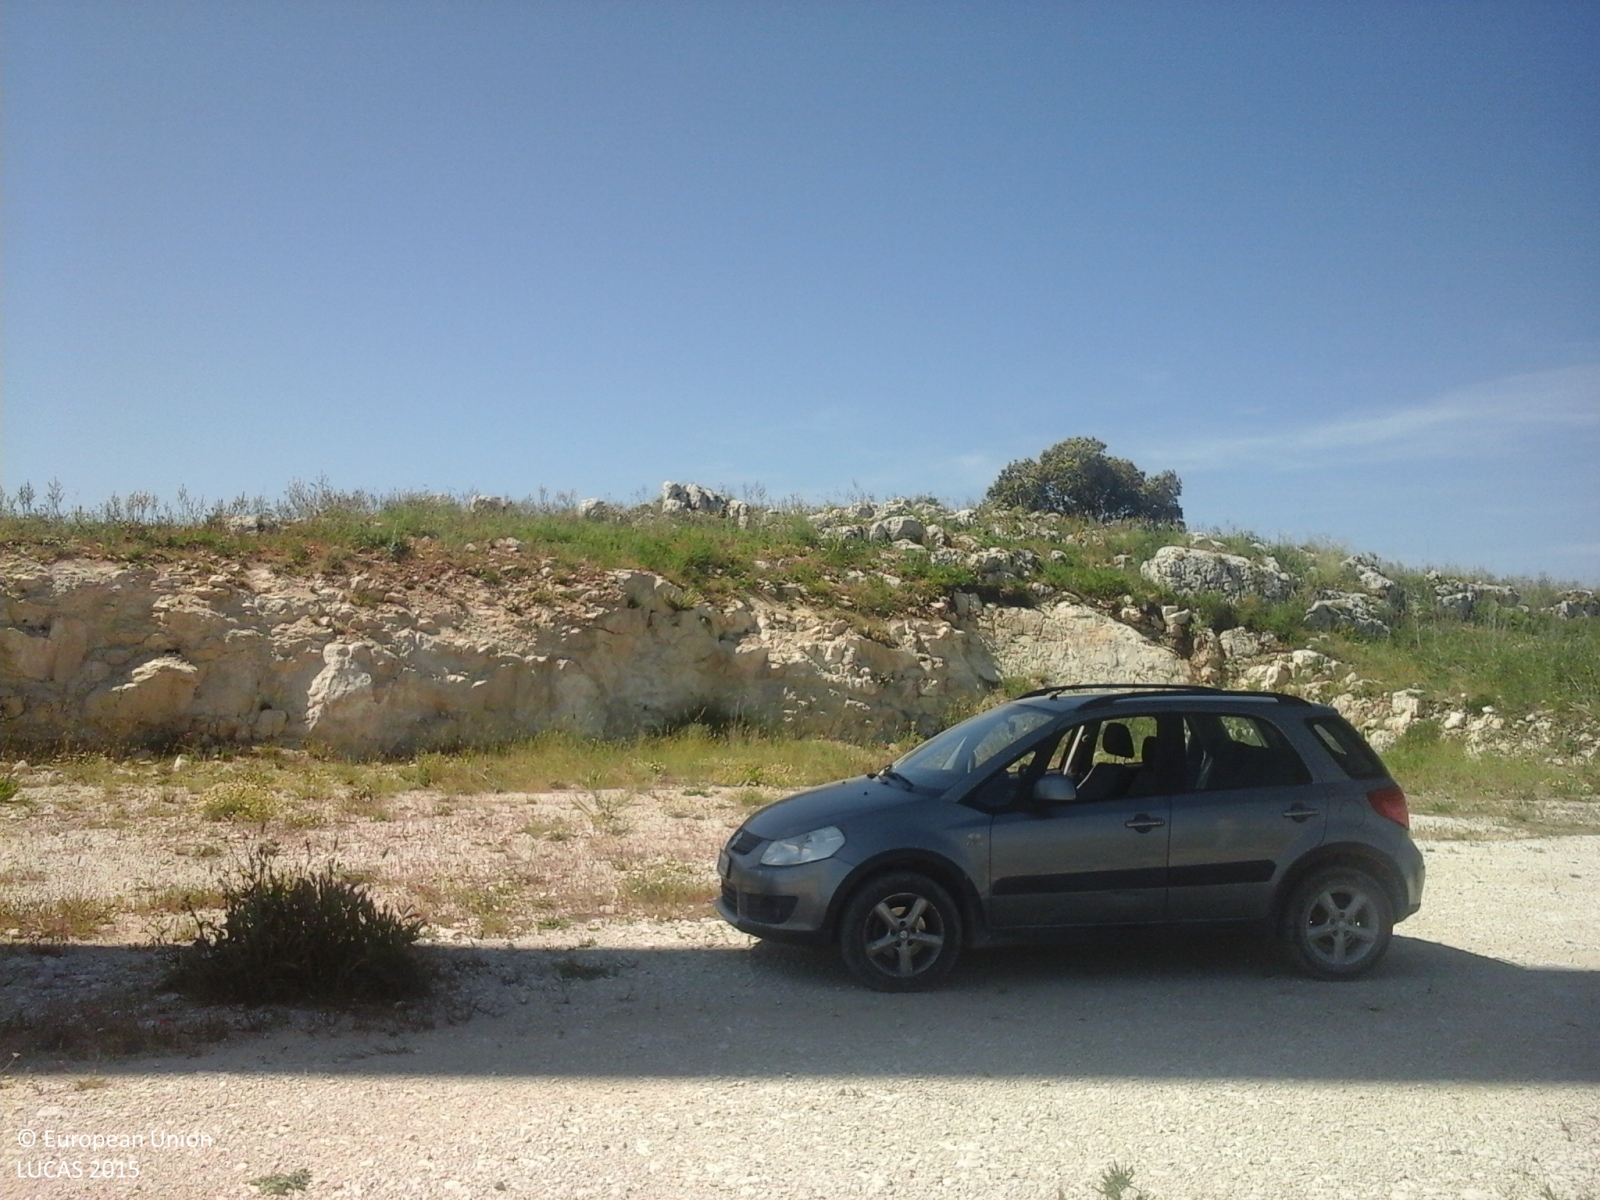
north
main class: Cropland
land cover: Durum wheat
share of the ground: > 75 %
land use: Agriculture (excluding fallow land and kitchen gardens)
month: May
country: IT
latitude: 37.6273
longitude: 13.9931
